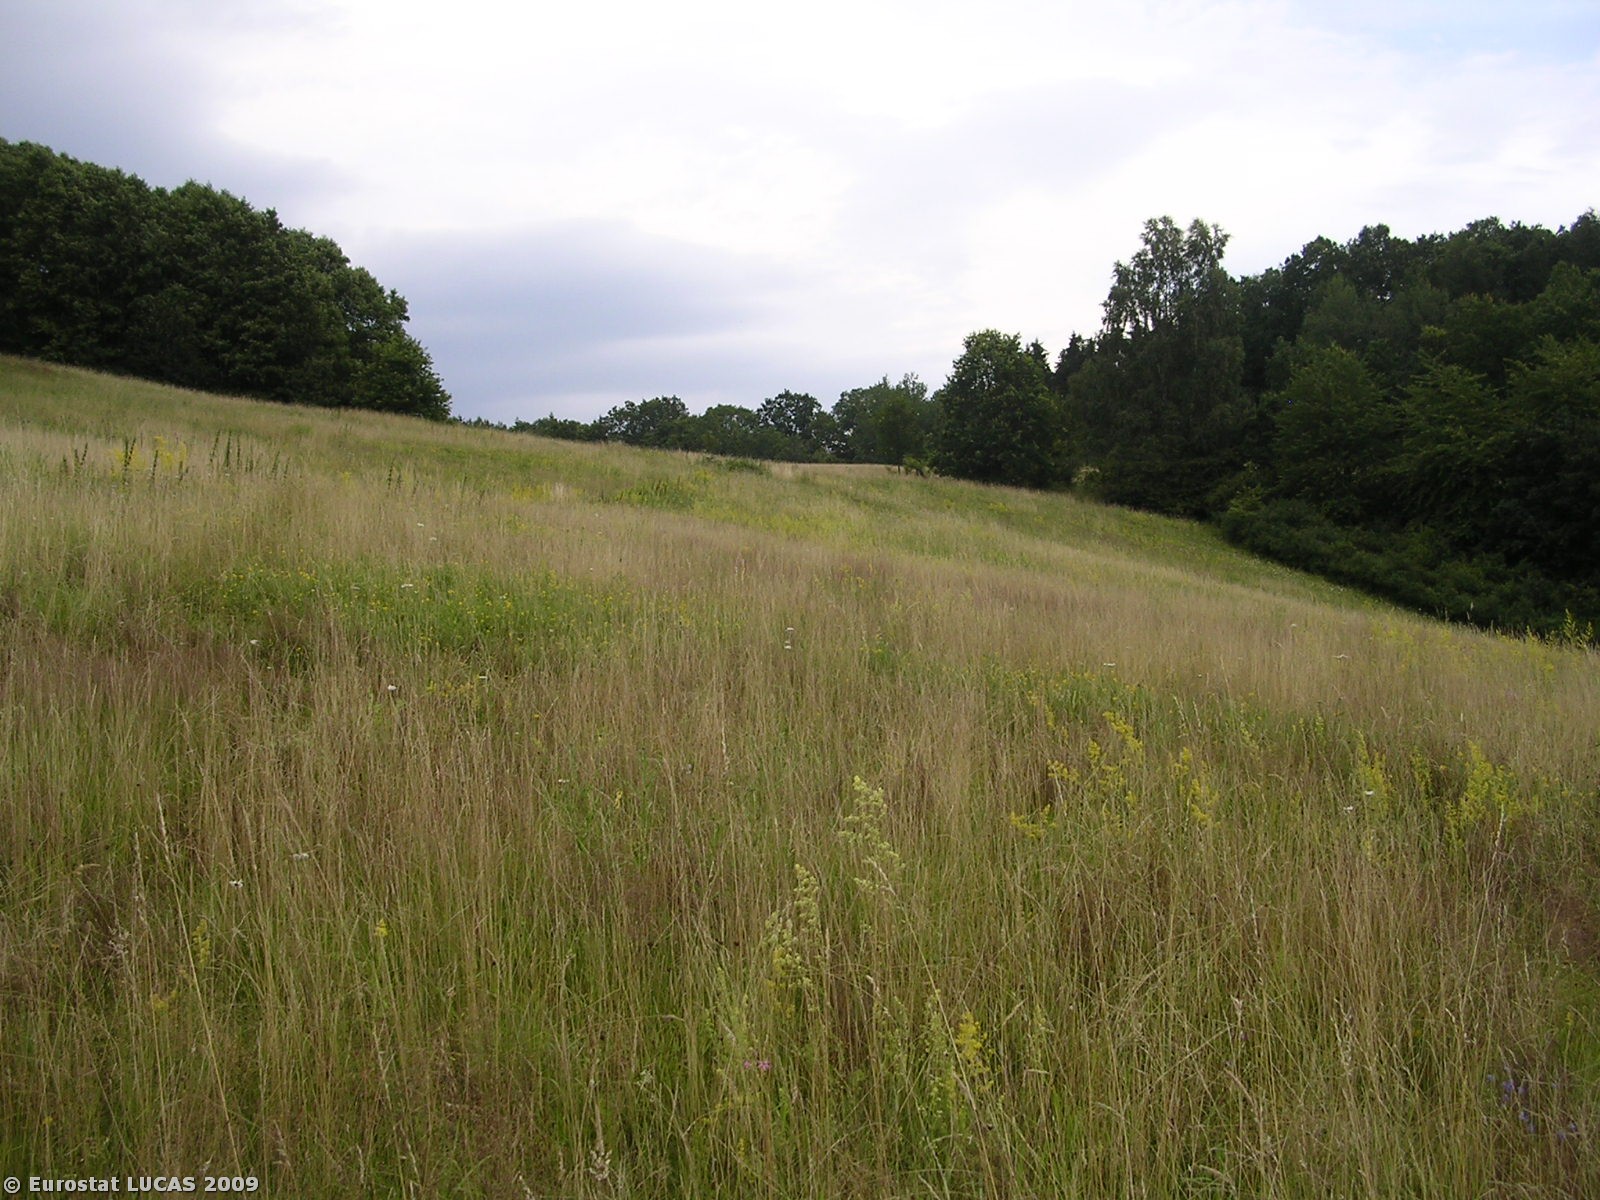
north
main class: Grassland
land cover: Grassland without tree/shrub cover
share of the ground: > 75 %
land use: Agriculture (excluding fallow land and kitchen gardens)
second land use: Nature reserves
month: July
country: CZ
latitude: 50.7684
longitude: 14.3261
